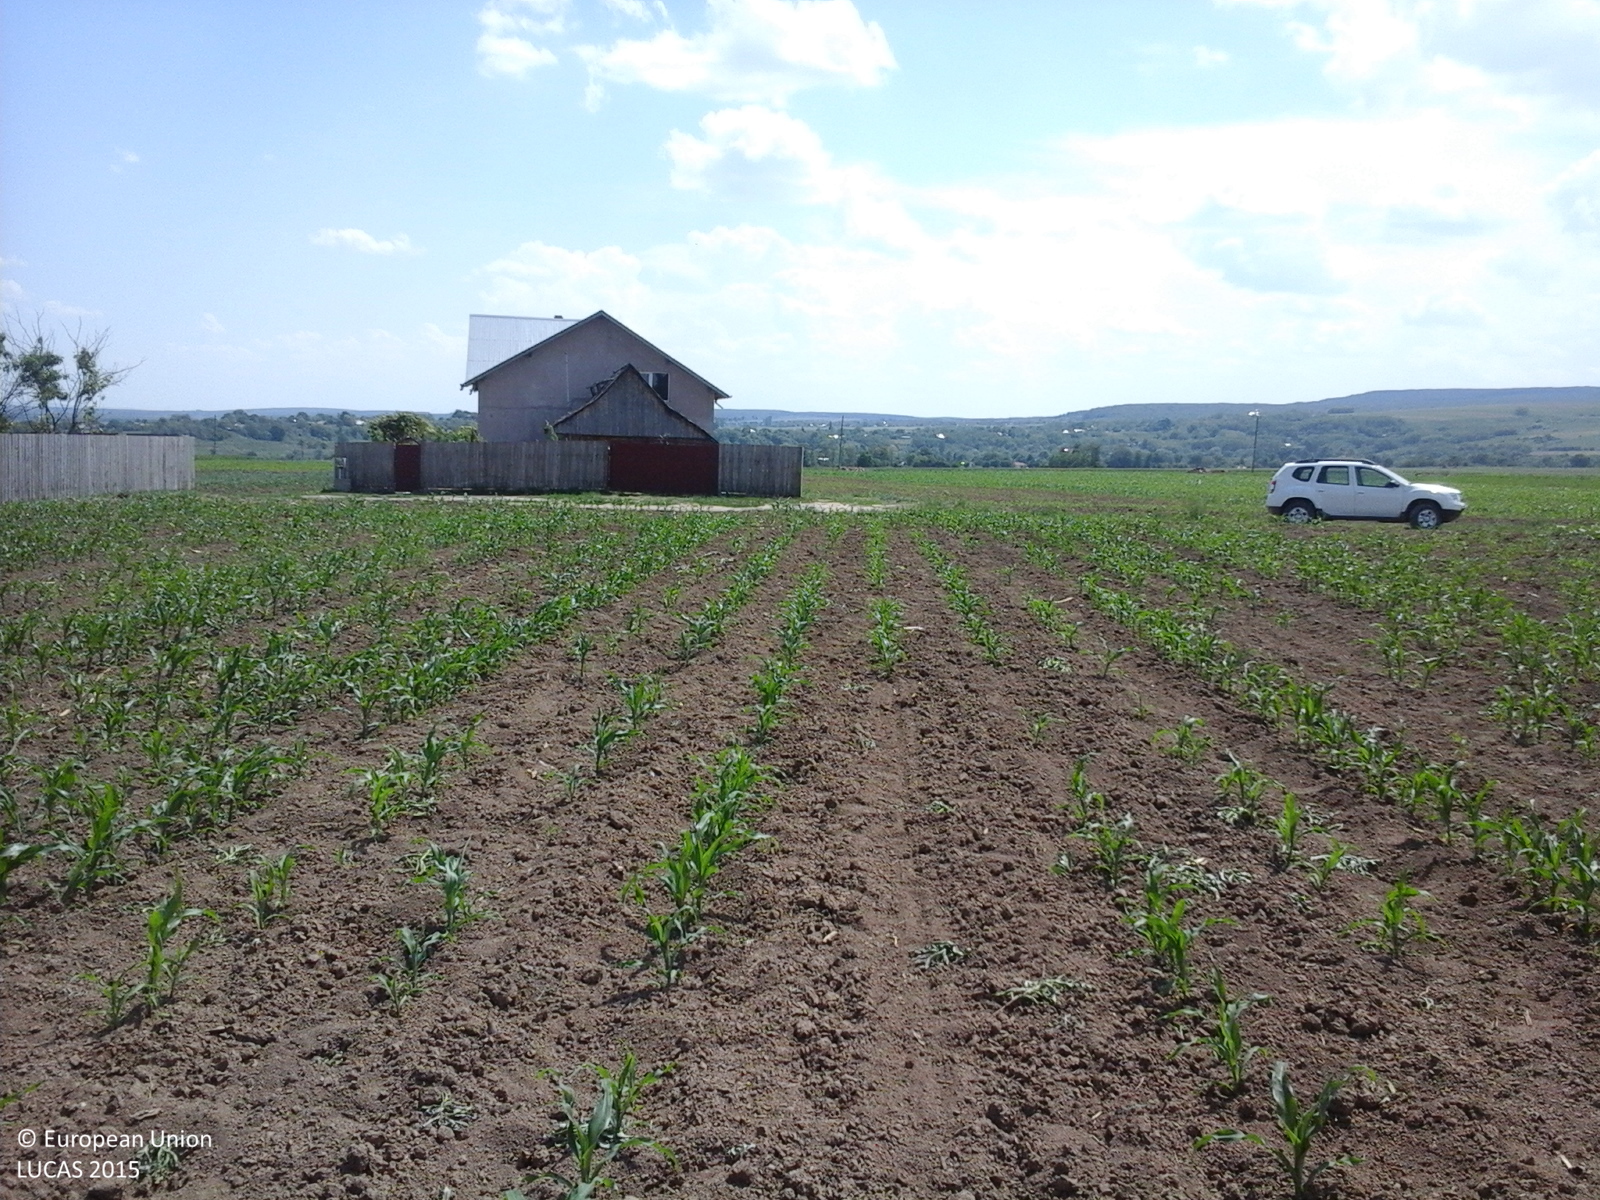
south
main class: Cropland
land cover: Maize
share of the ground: 10 - 25 %
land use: Agriculture (excluding fallow land and kitchen gardens)
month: June
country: RO
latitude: 46.7938
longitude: 26.7960
